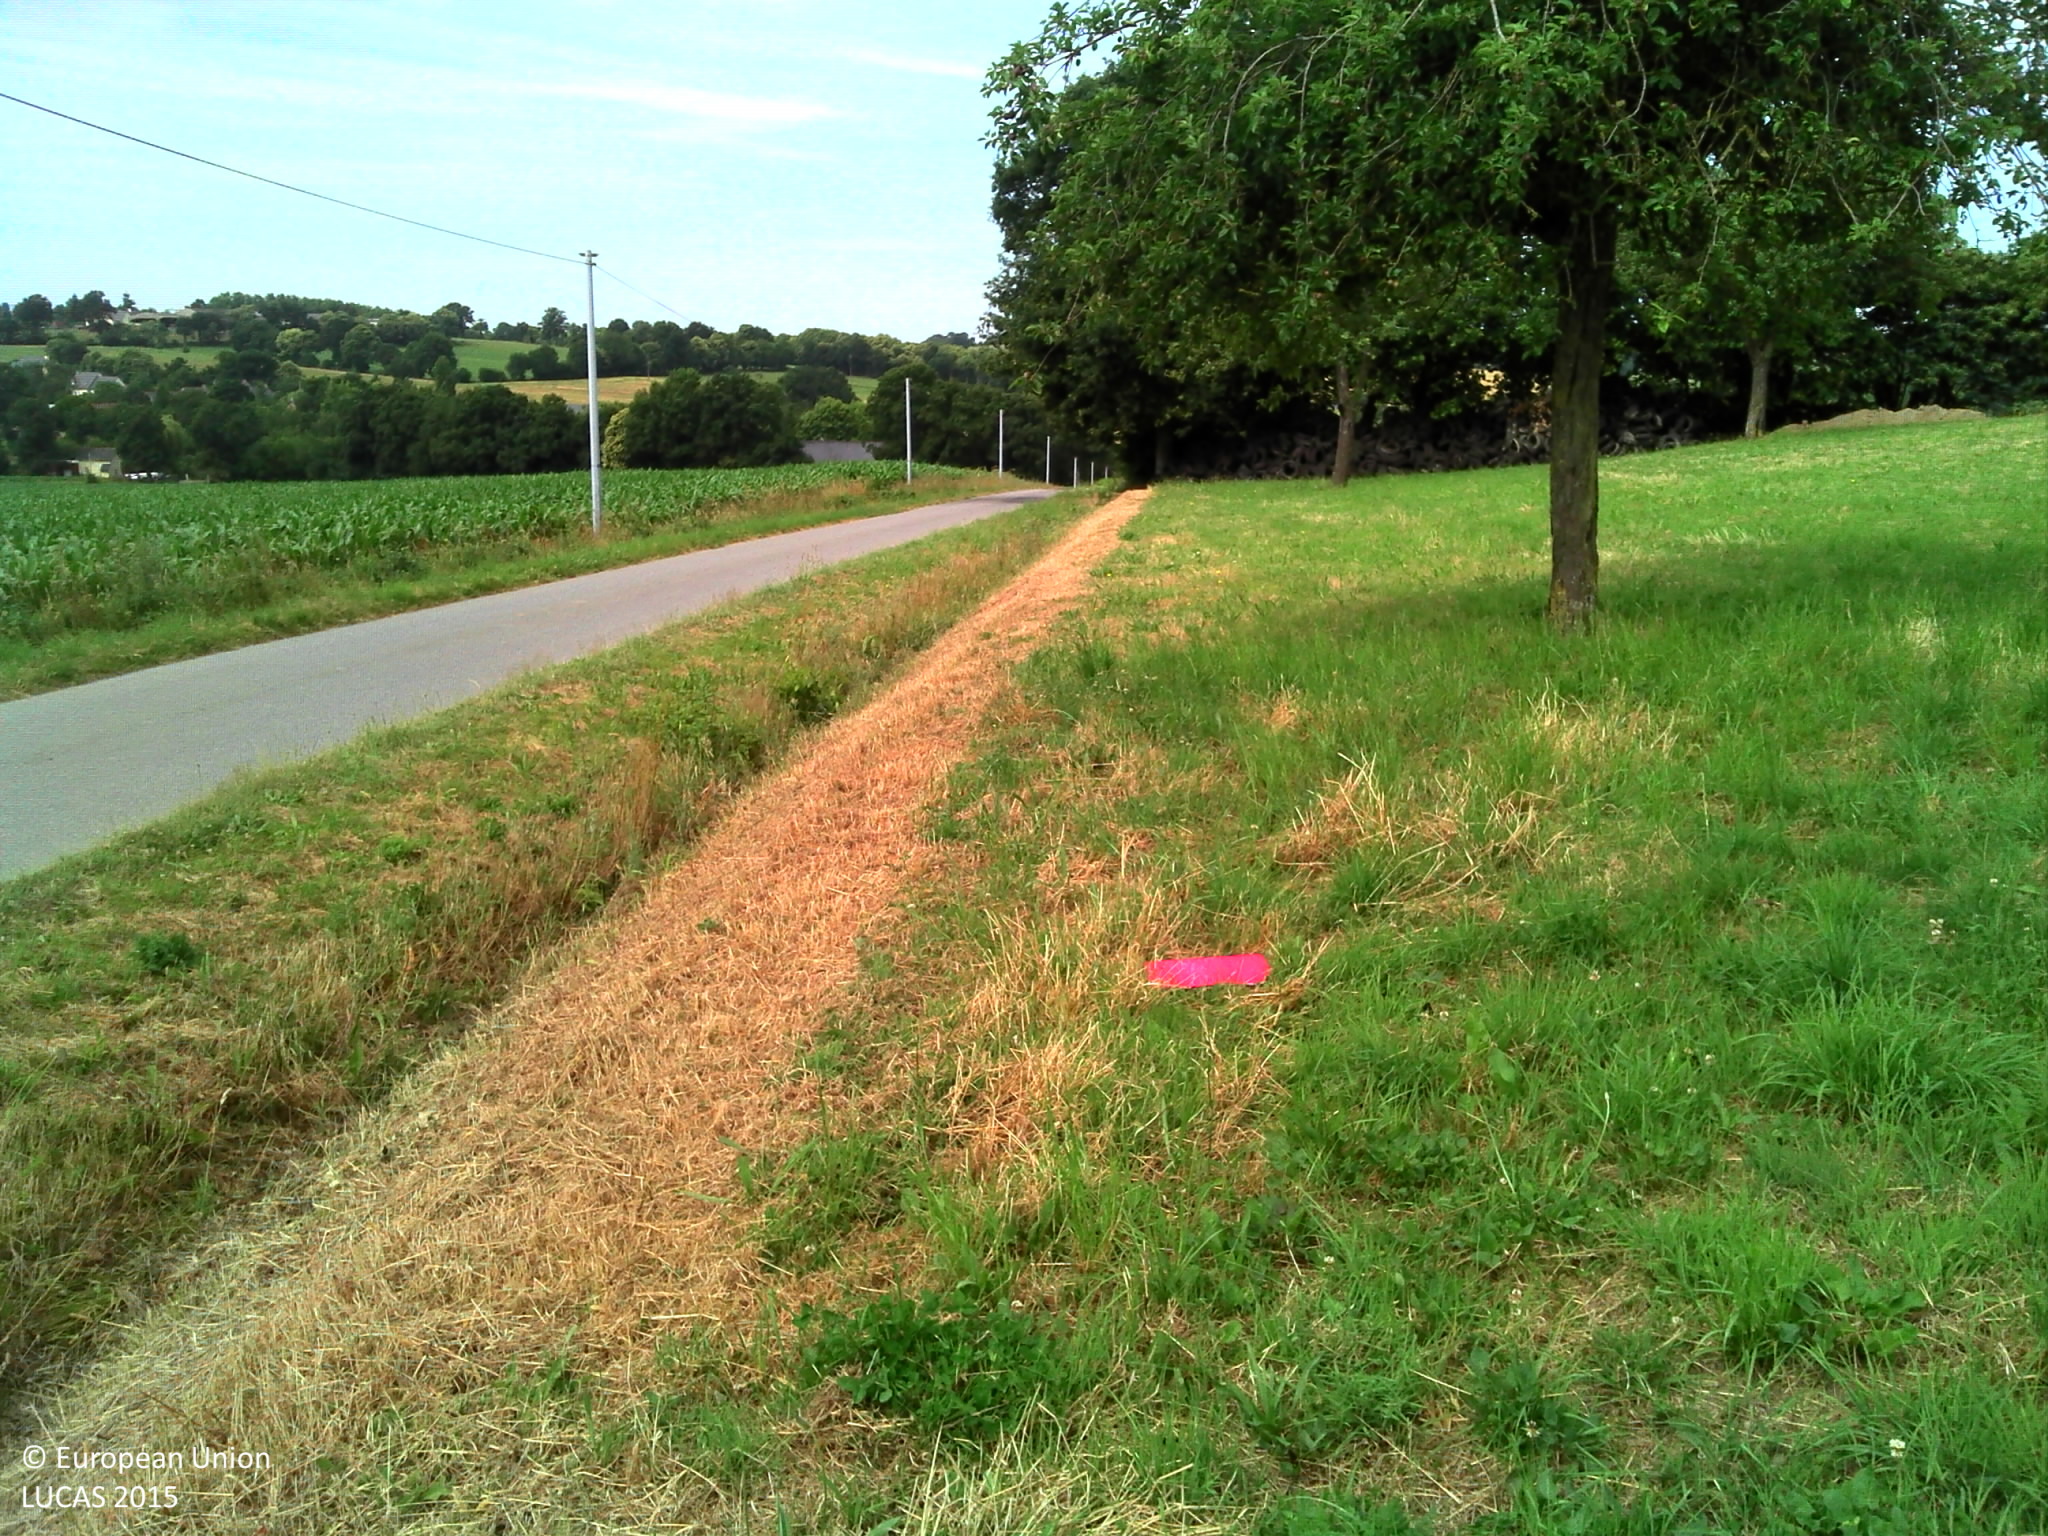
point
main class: Cropland
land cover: Apple fruit
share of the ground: > 75 %
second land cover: Grassland without tree/shrub cover
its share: > 75 %
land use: Agriculture (excluding fallow land and kitchen gardens)
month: June
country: FR
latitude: 47.9362
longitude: -1.5984
